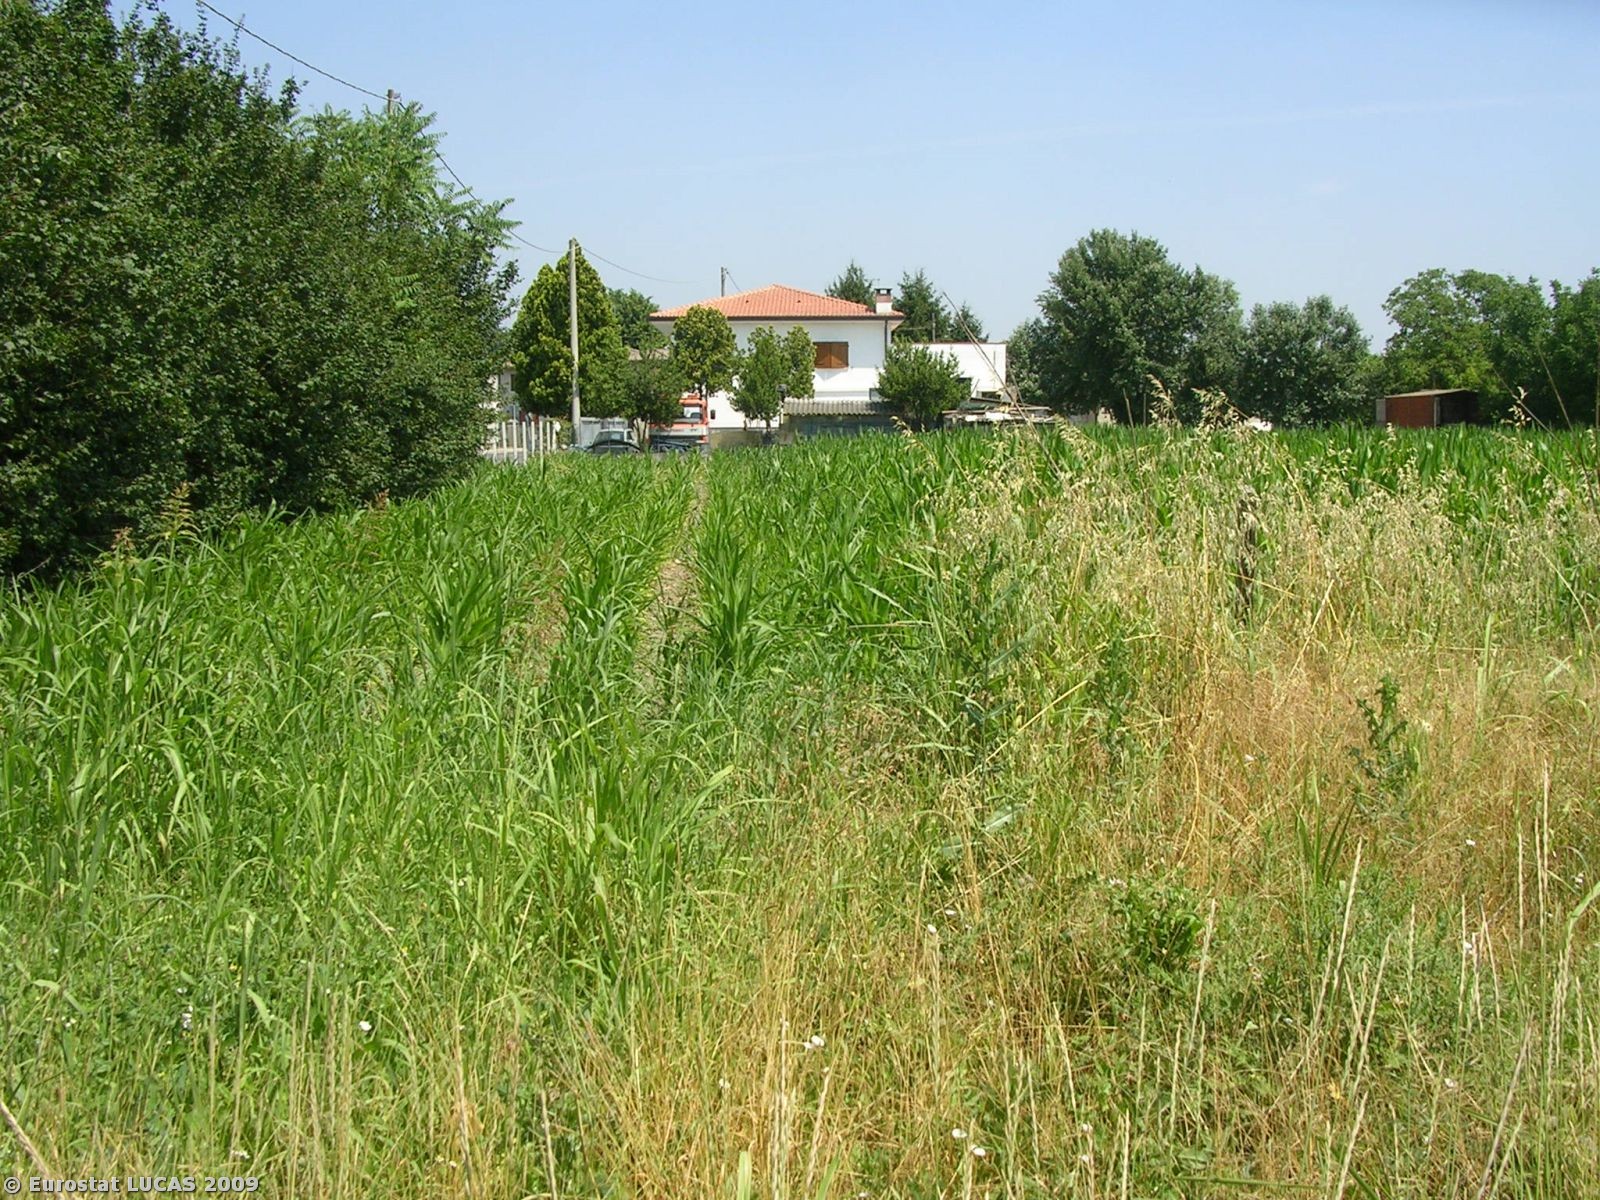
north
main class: Grassland
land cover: Spontaneously vegetated surfaces
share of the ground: > 75 %
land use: Residential
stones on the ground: < 10 %
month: June
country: IT
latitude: 45.1480
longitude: 11.7139
